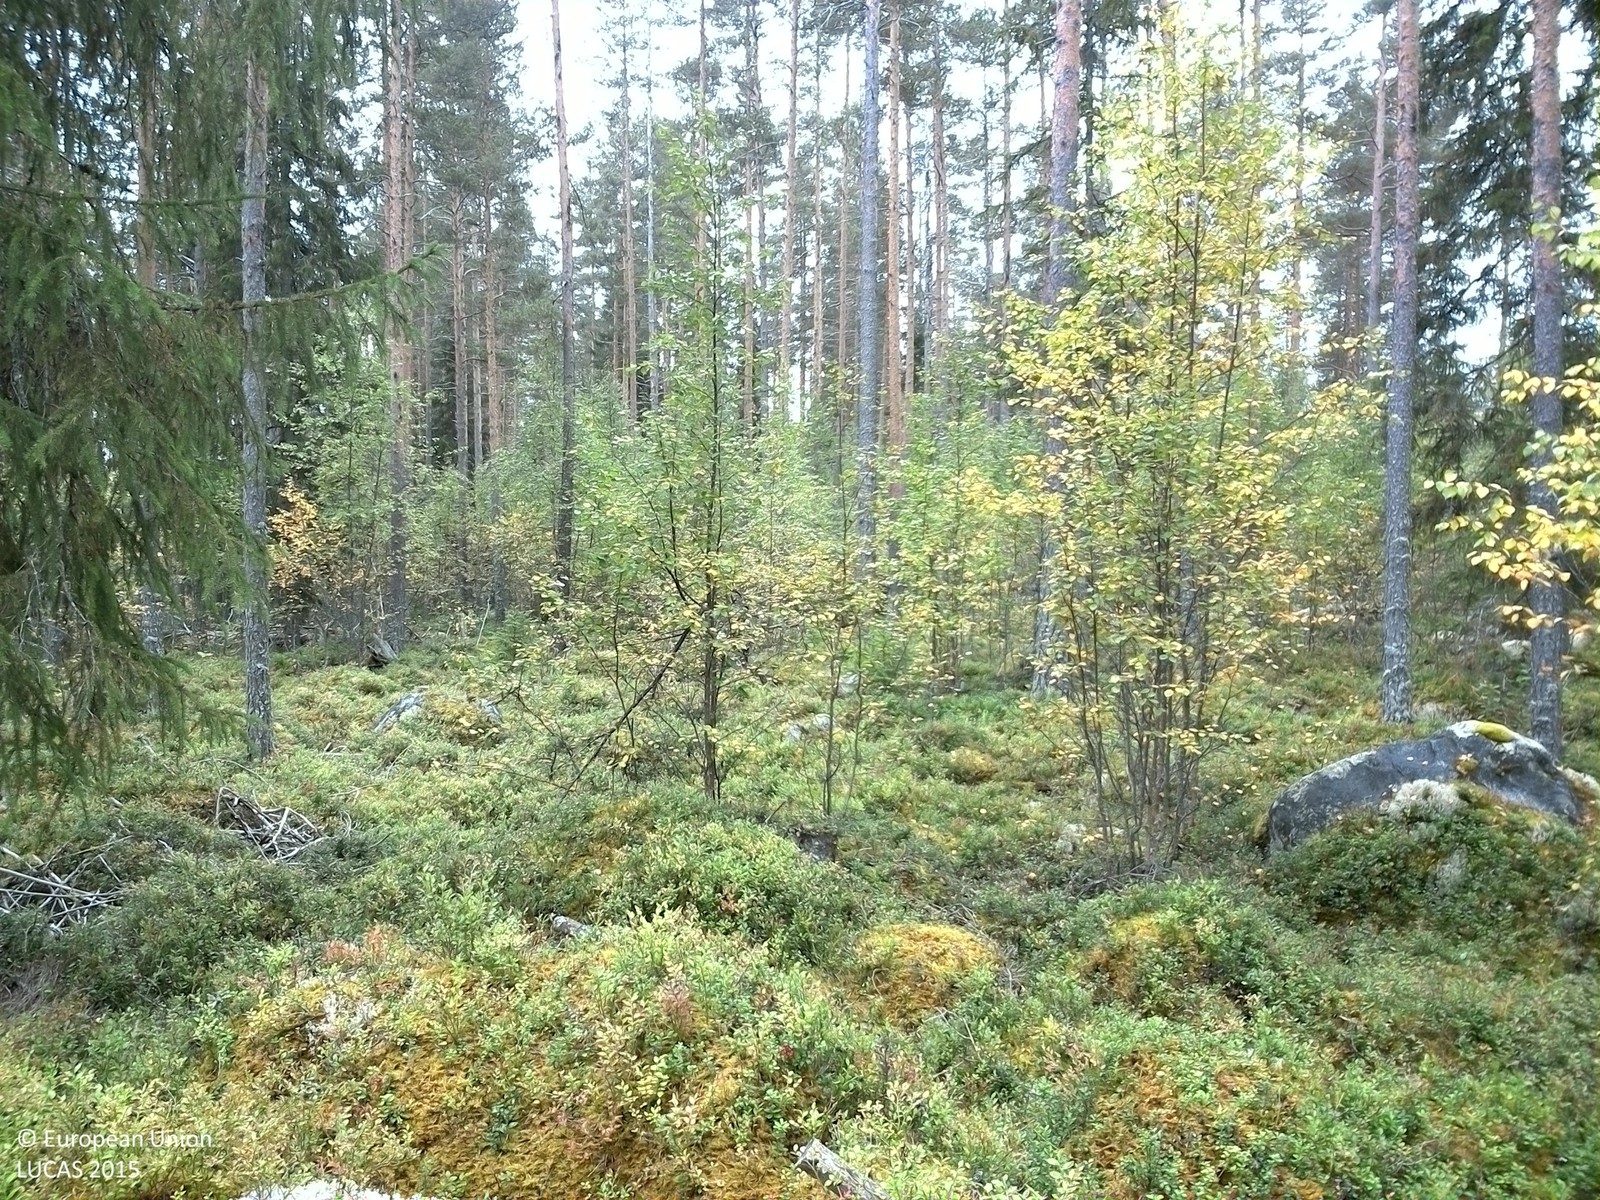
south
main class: Woodland
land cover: Pine dominated mixed woodland
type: boreal forest
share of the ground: 50 - 75 %
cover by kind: coniferous forest trees 40 %, shrubs 25 %, broadleaved forest trees 20 %, lichens and mosses 10 %, consolidated bare surface 5 %
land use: Forestry
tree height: > 5 m
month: September
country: SE
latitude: 61.6602
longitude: 15.0635
